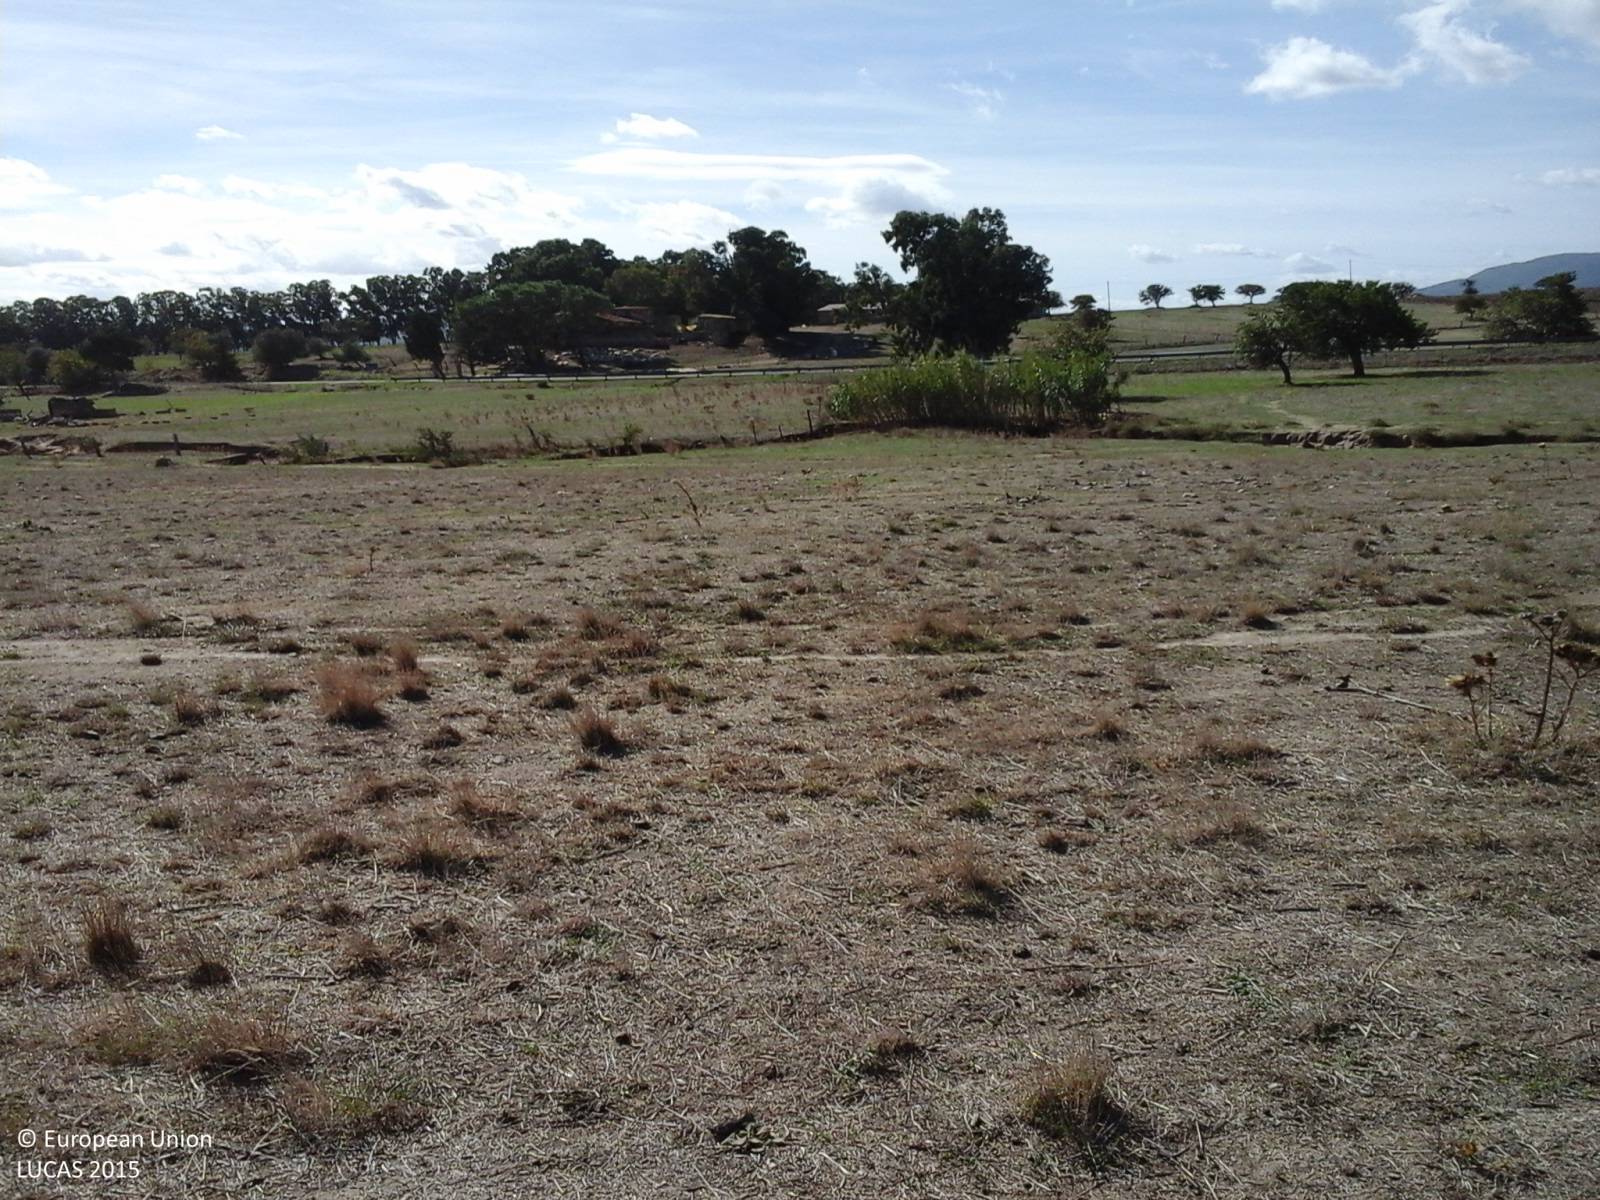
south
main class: Grassland
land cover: Grassland without tree/shrub cover
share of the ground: > 75 %
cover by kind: herbaceous plants 100 %
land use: Agriculture (excluding fallow land and kitchen gardens)
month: October
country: IT
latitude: 40.4259
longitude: 9.0736
